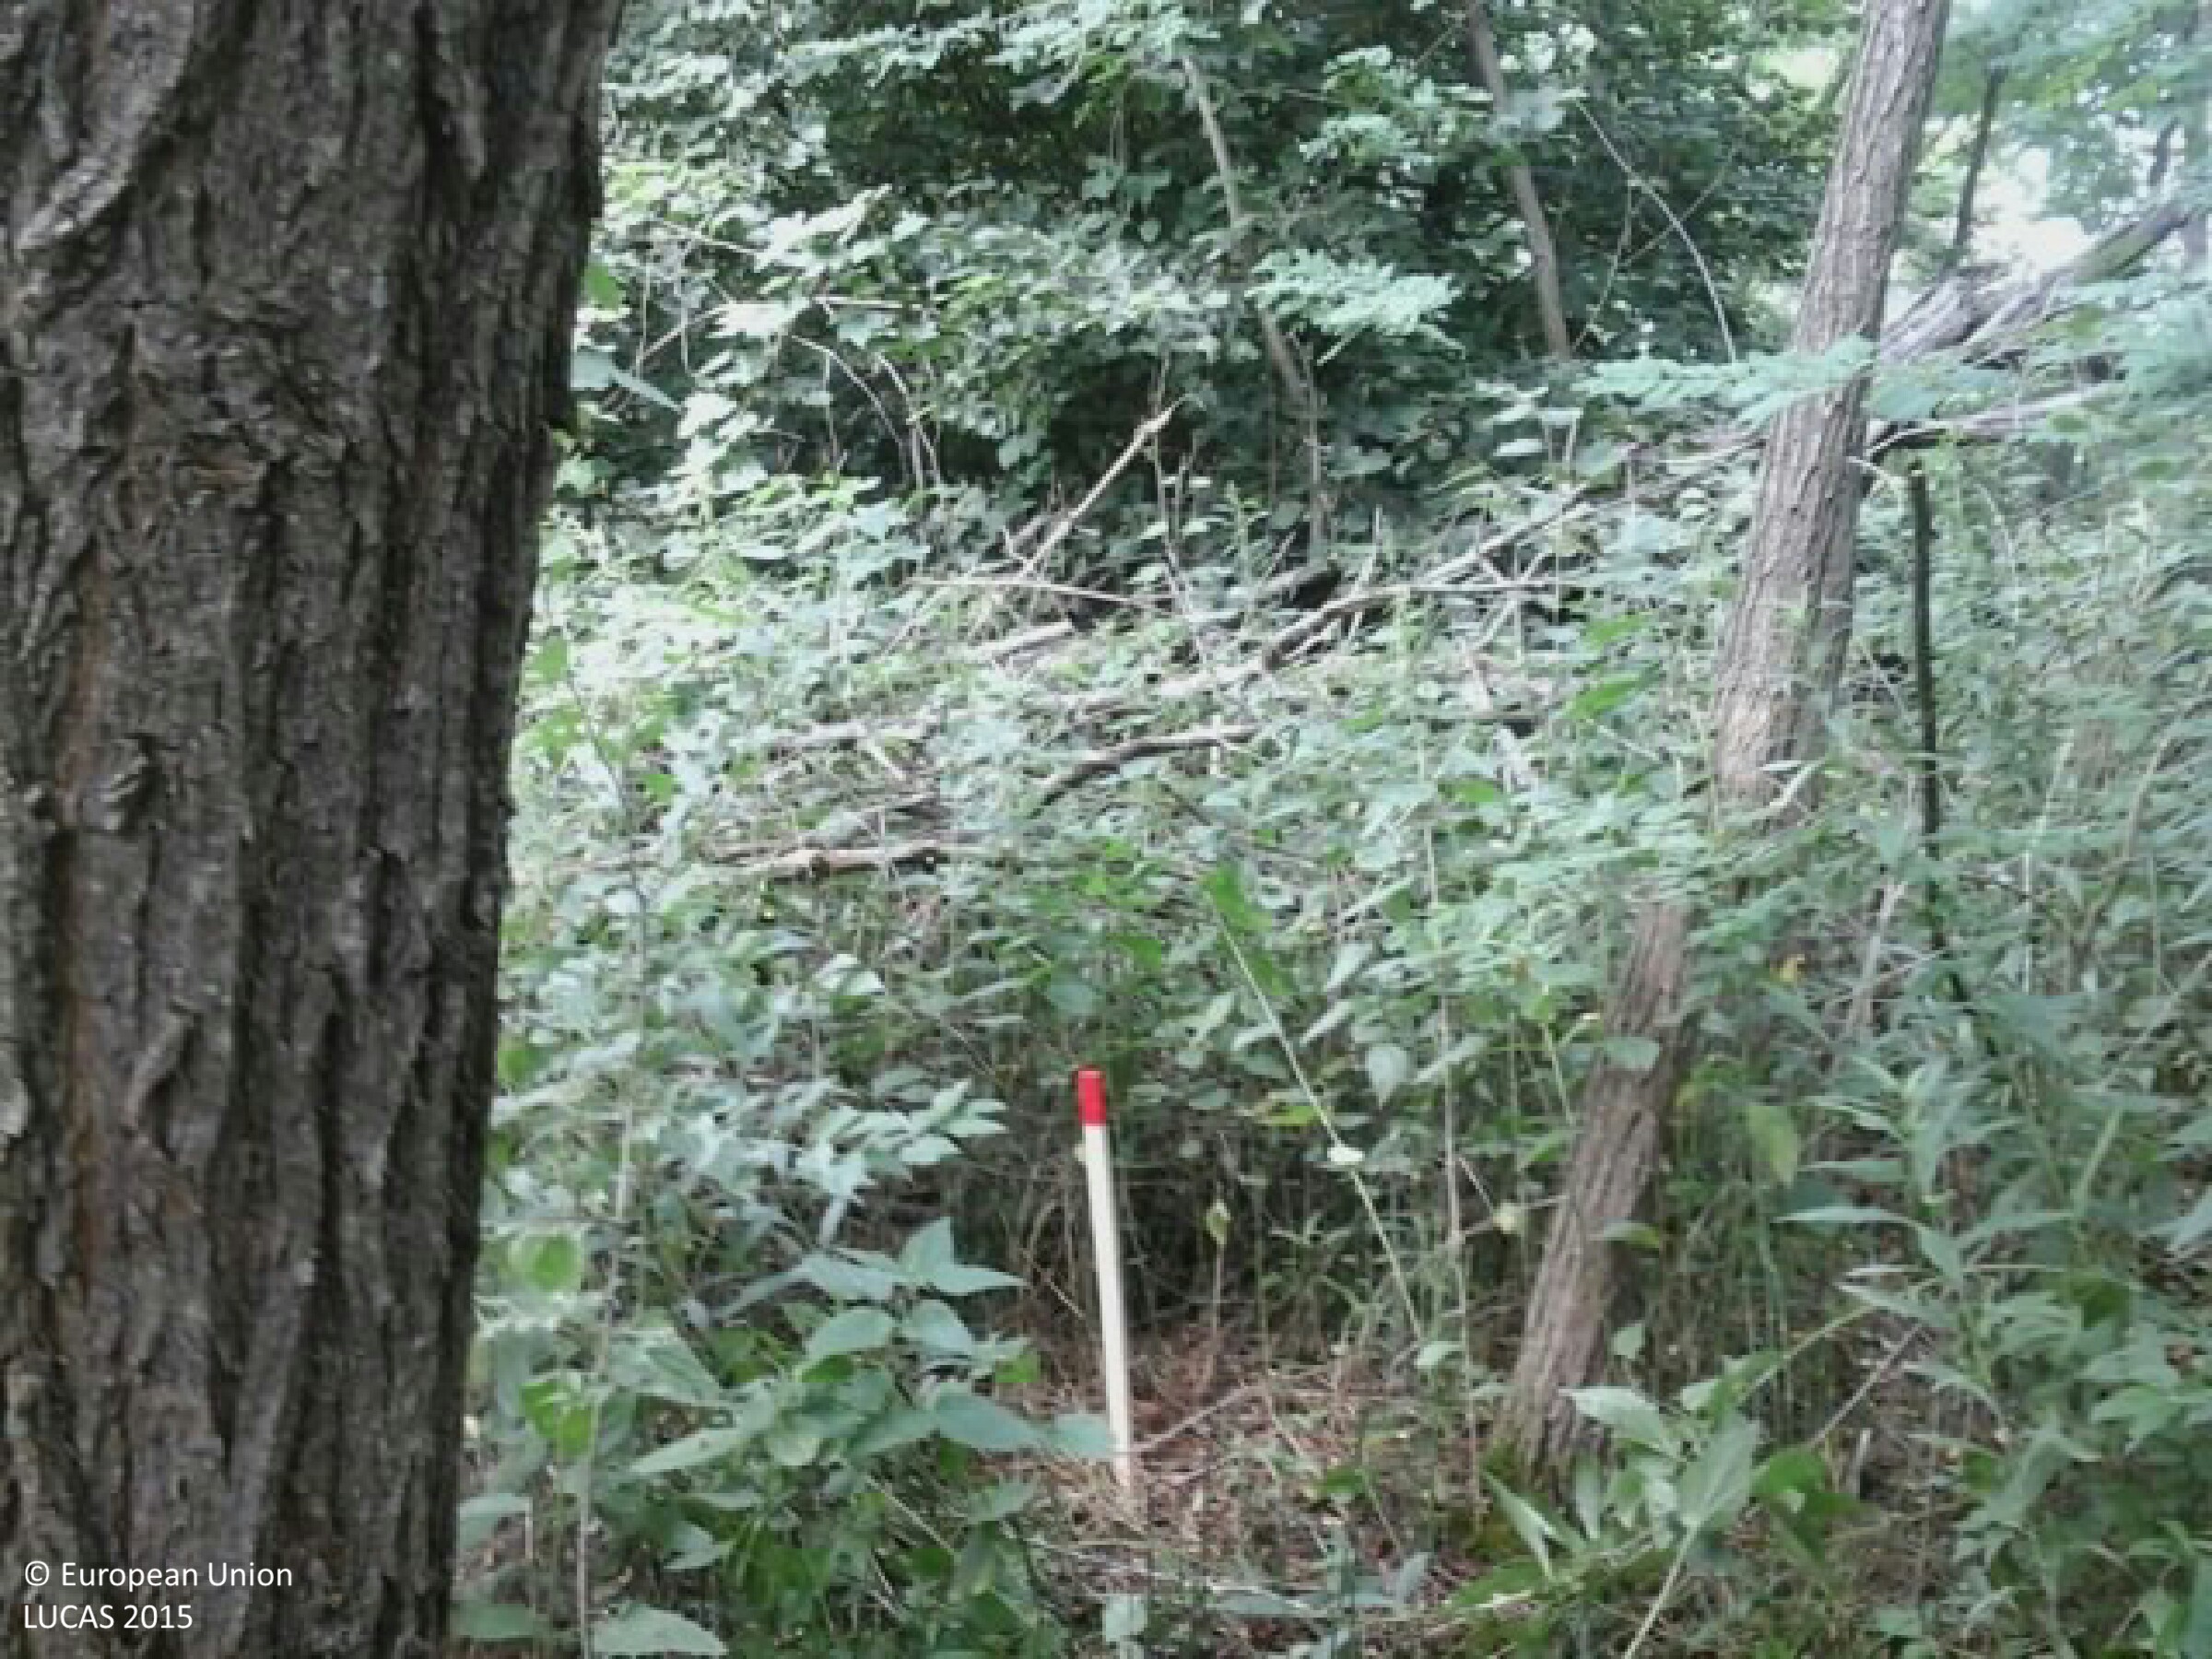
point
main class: Woodland
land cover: Broadleaved woodland
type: exotic forest
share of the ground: > 75 %
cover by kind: broadleaved forest trees 90 %, shrubs 5 %, herbaceous plants 5 %
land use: Forestry
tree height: > 5 m
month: July
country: HU
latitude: 46.4689
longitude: 16.9437
